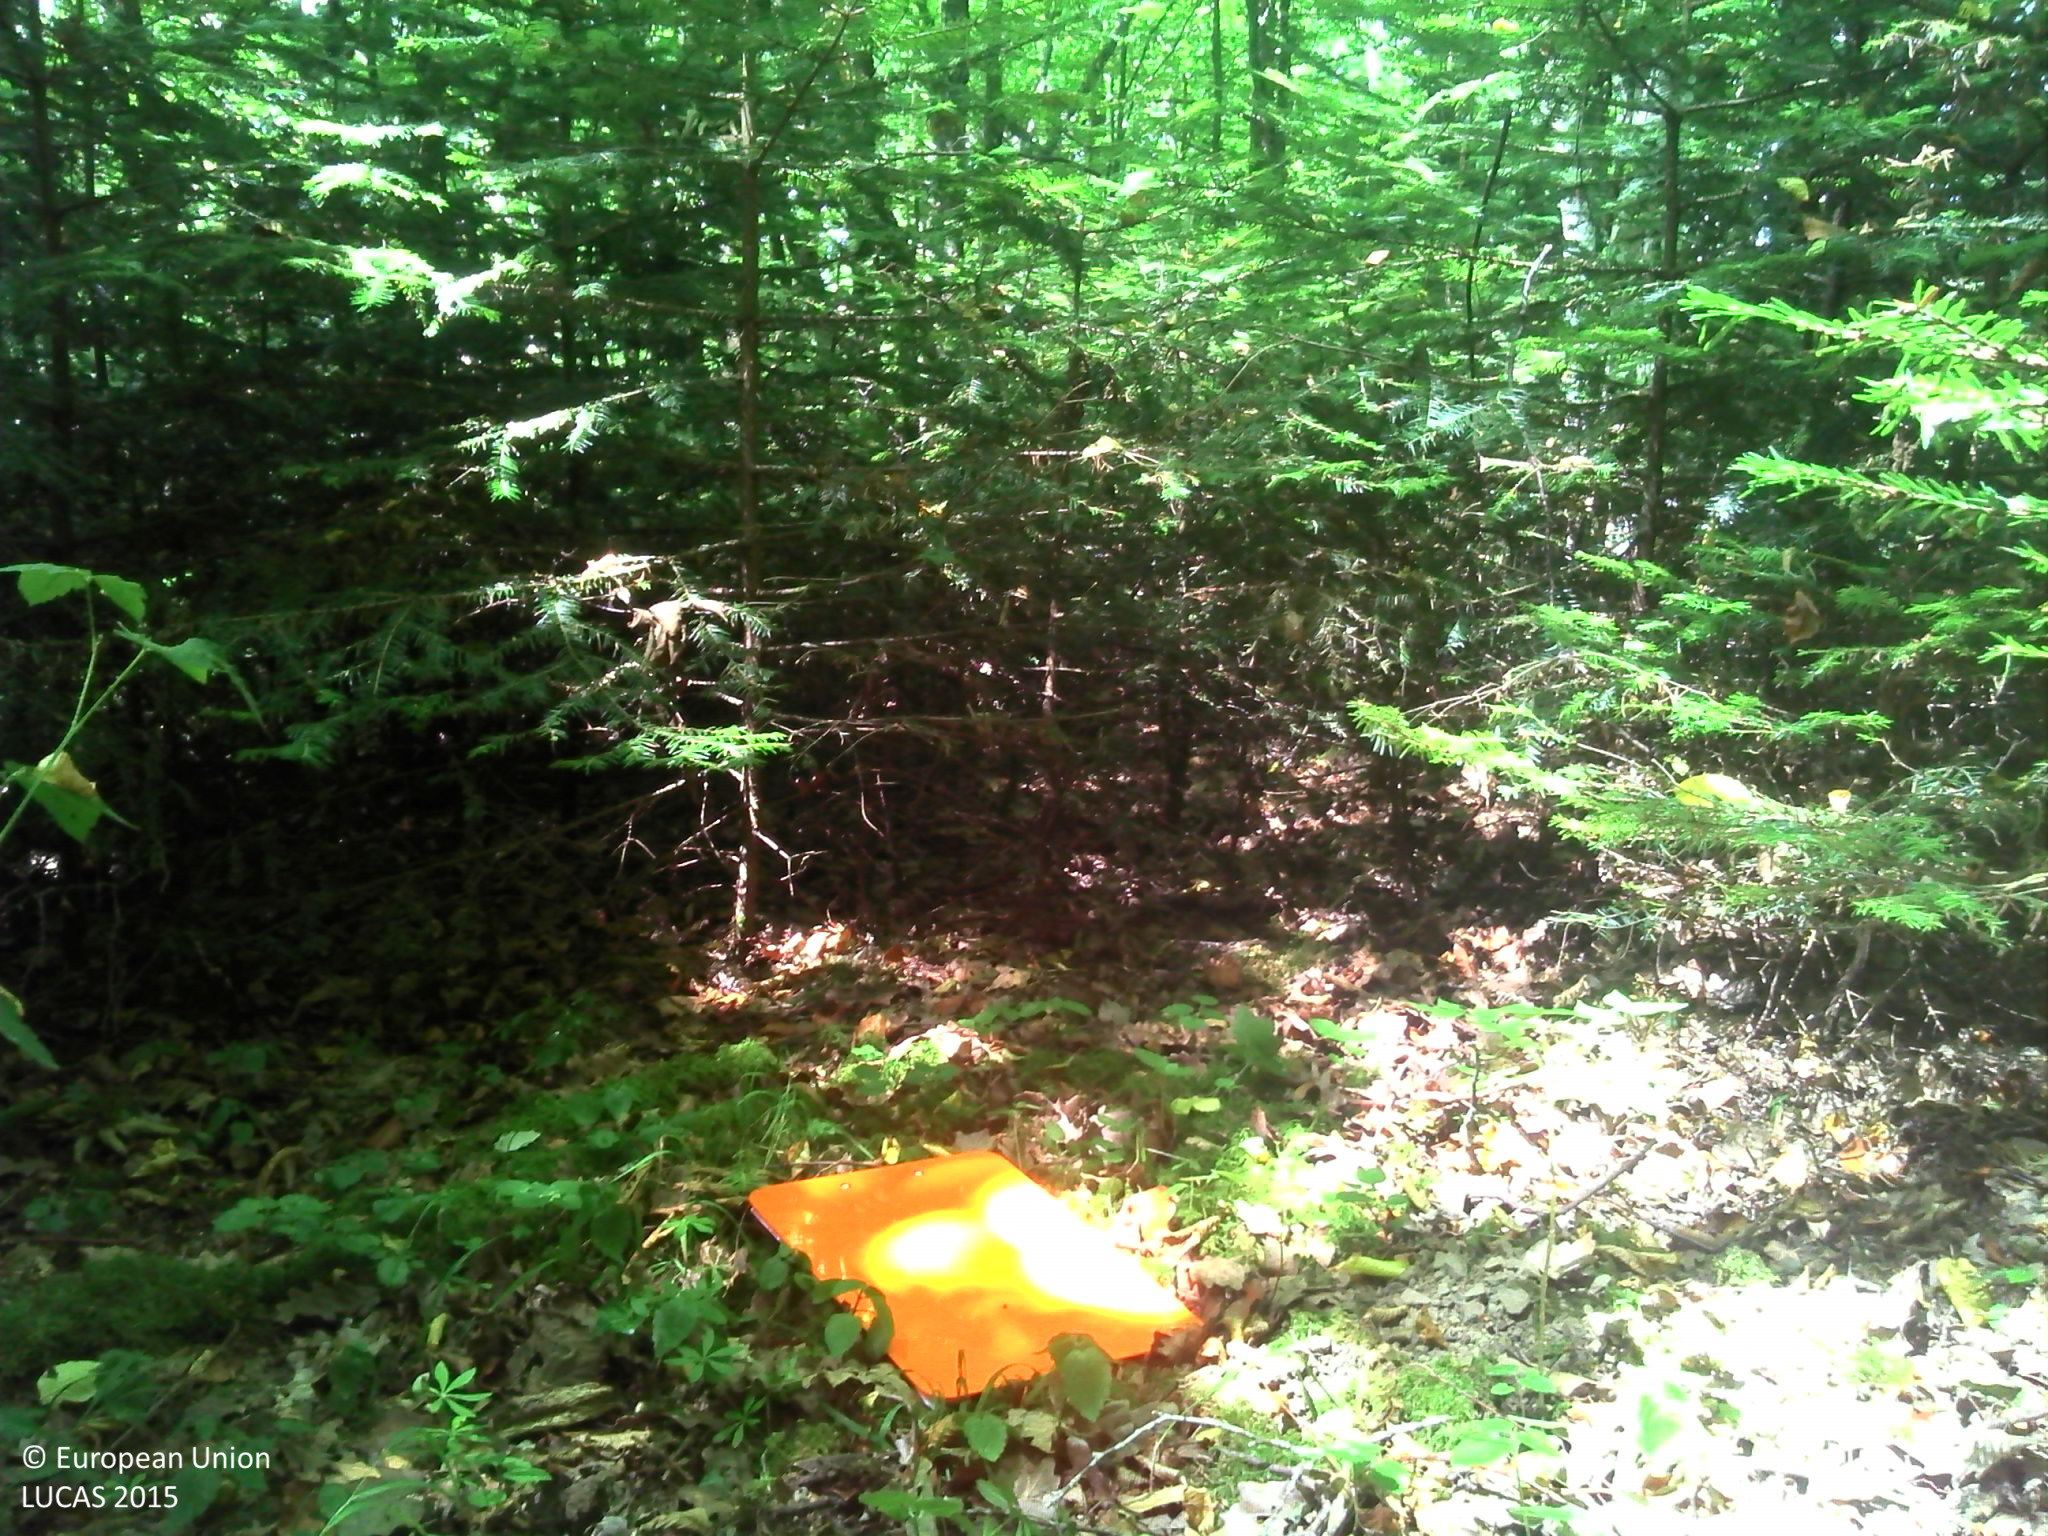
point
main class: Woodland
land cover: Other mixed woodland
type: mountainous beech forest
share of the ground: > 75 %
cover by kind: coniferous forest trees 40 %, broadleaved forest trees 40 %, herbaceous plants 20 %
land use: Forestry
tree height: > 5 m
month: July
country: FR
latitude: 45.7757
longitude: 4.4859
